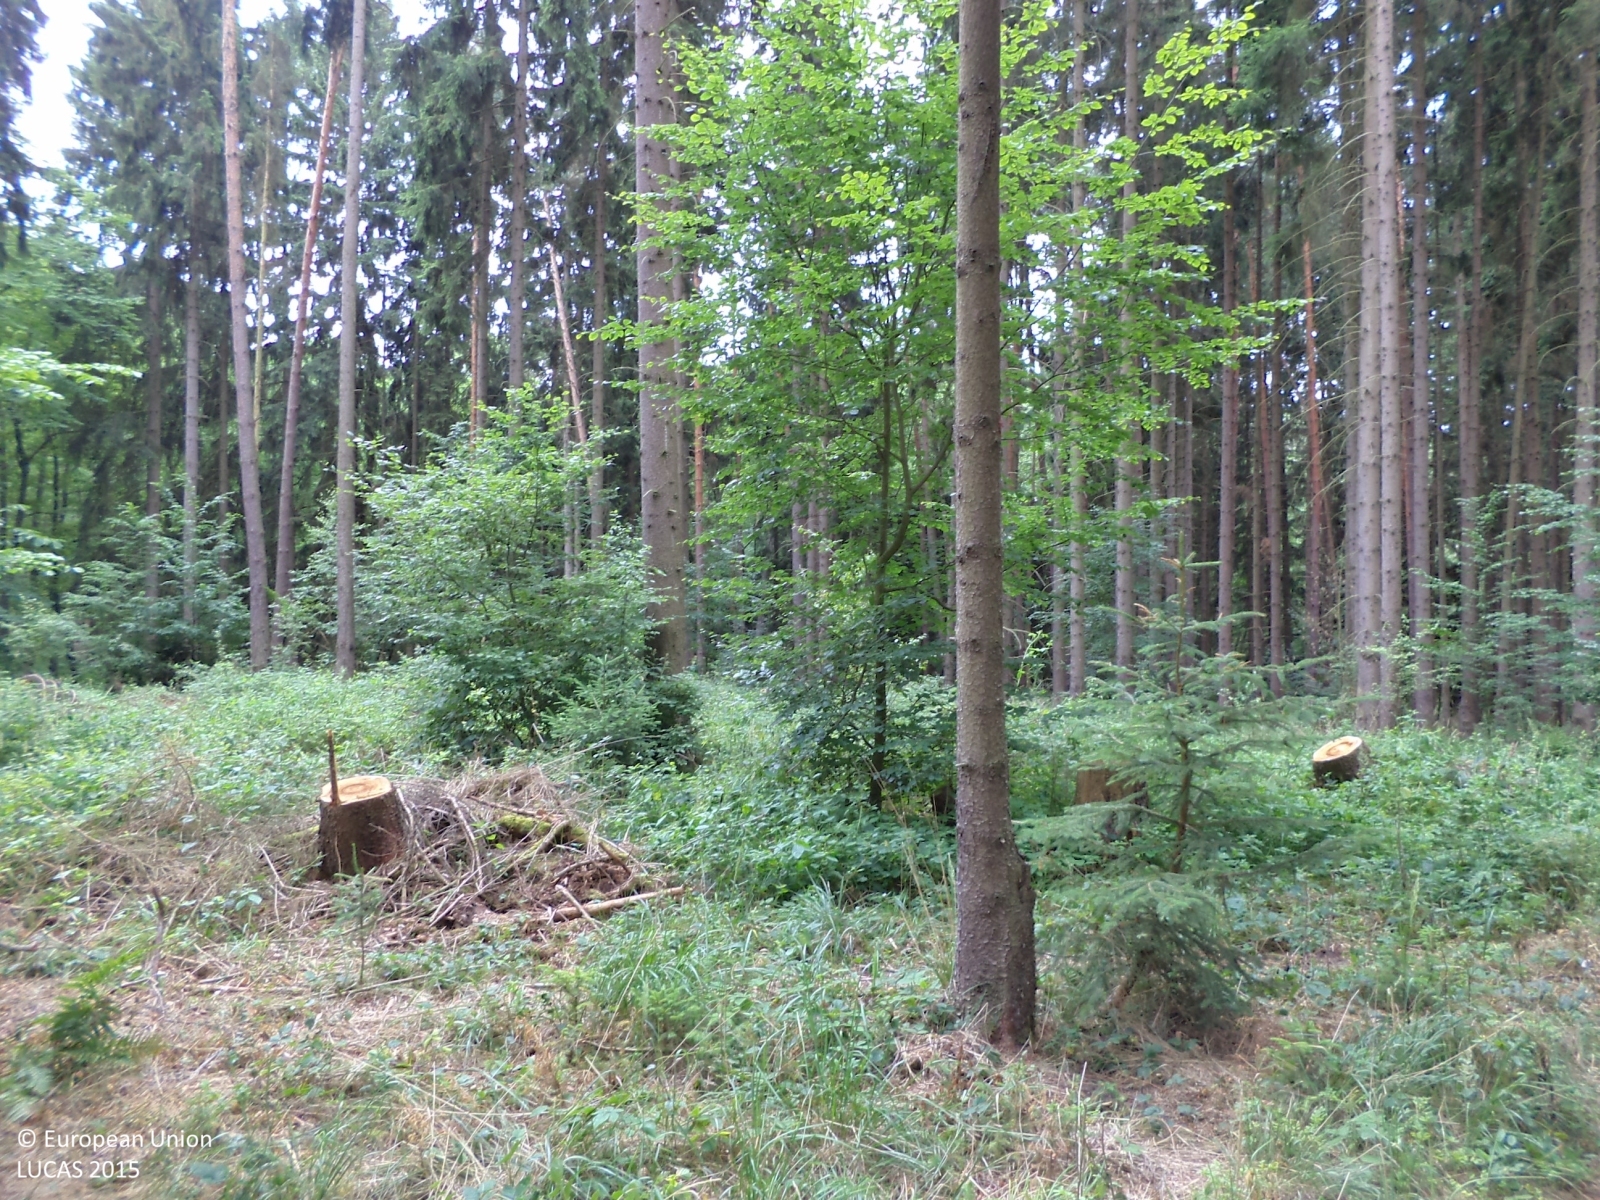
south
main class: Woodland
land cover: Spruce dominated coniferous woodland
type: hemiboreal forest and nemoral coniferous forest and mixed broadleaved-coniferous forest
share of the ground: > 75 %
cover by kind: coniferous forest trees 80 %, herbaceous plants 20 %
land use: Forestry
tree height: > 5 m
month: July
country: CZ
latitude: 50.0408
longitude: 14.0362
